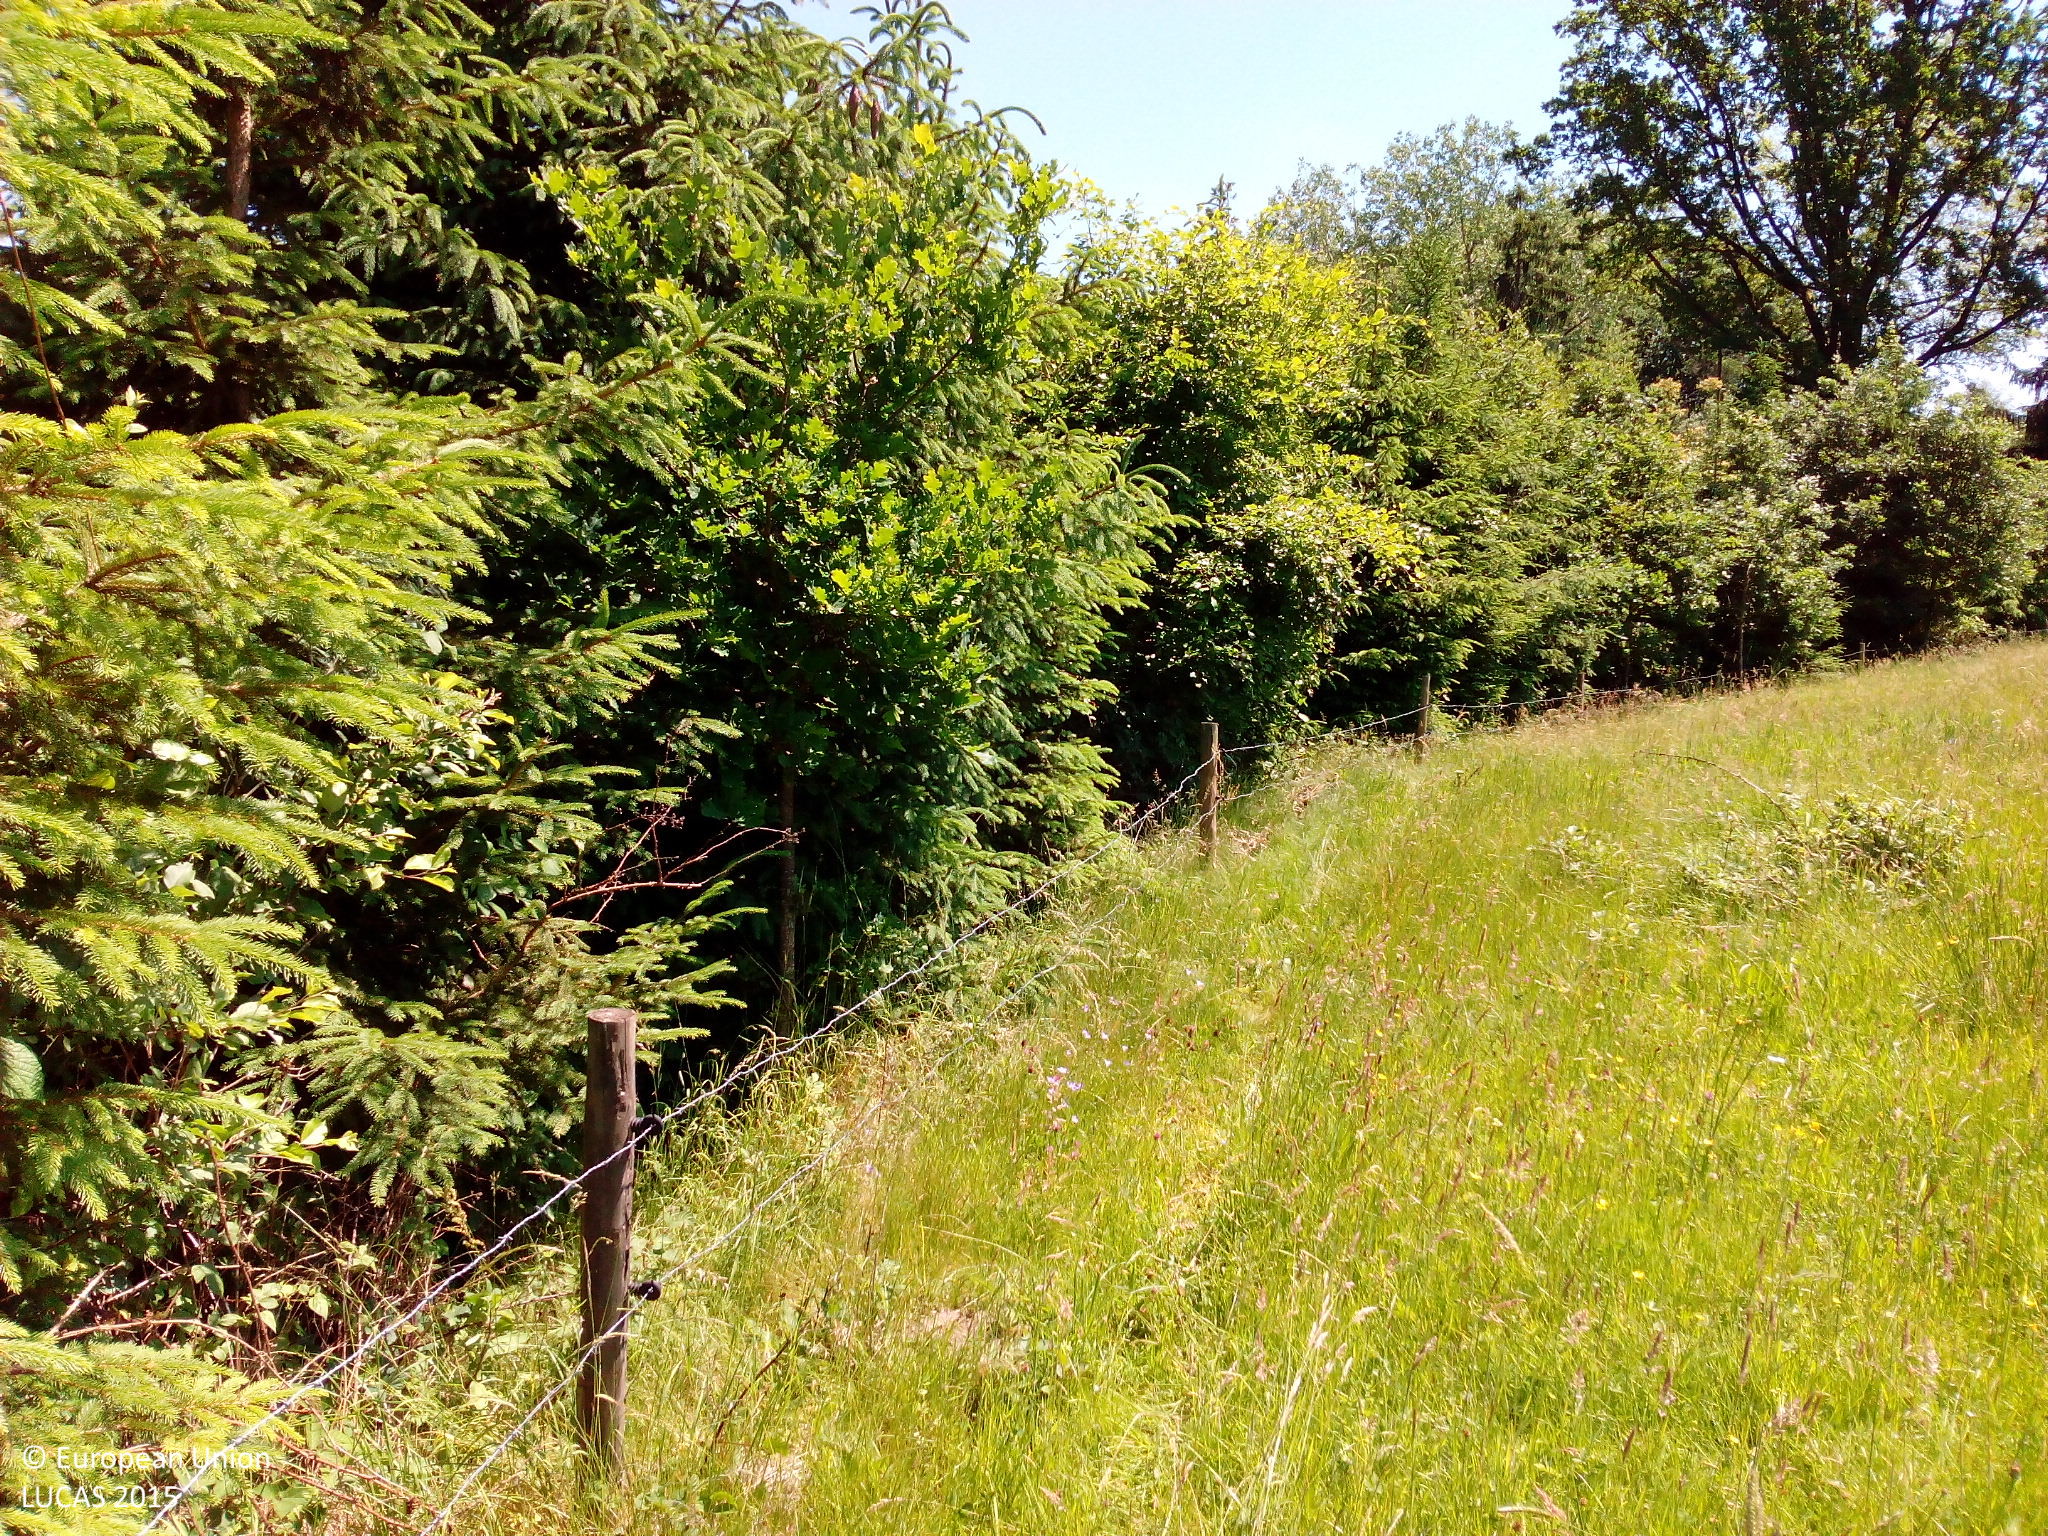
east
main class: Woodland
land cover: Spruce dominated mixed woodland
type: hemiboreal forest and nemoral coniferous forest and mixed broadleaved-coniferous forest
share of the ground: > 75 %
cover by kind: coniferous forest trees 65 %, broadleaved forest trees 35 %
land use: Forestry
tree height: < 5 m
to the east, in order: Spruce dominated mixed woodland; Broadleaved woodland; Tracks; Shrubland with sparse tree cover; Tracks; Spruce dominated coniferous woodland
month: June
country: DE
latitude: 48.9966
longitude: 9.6311
